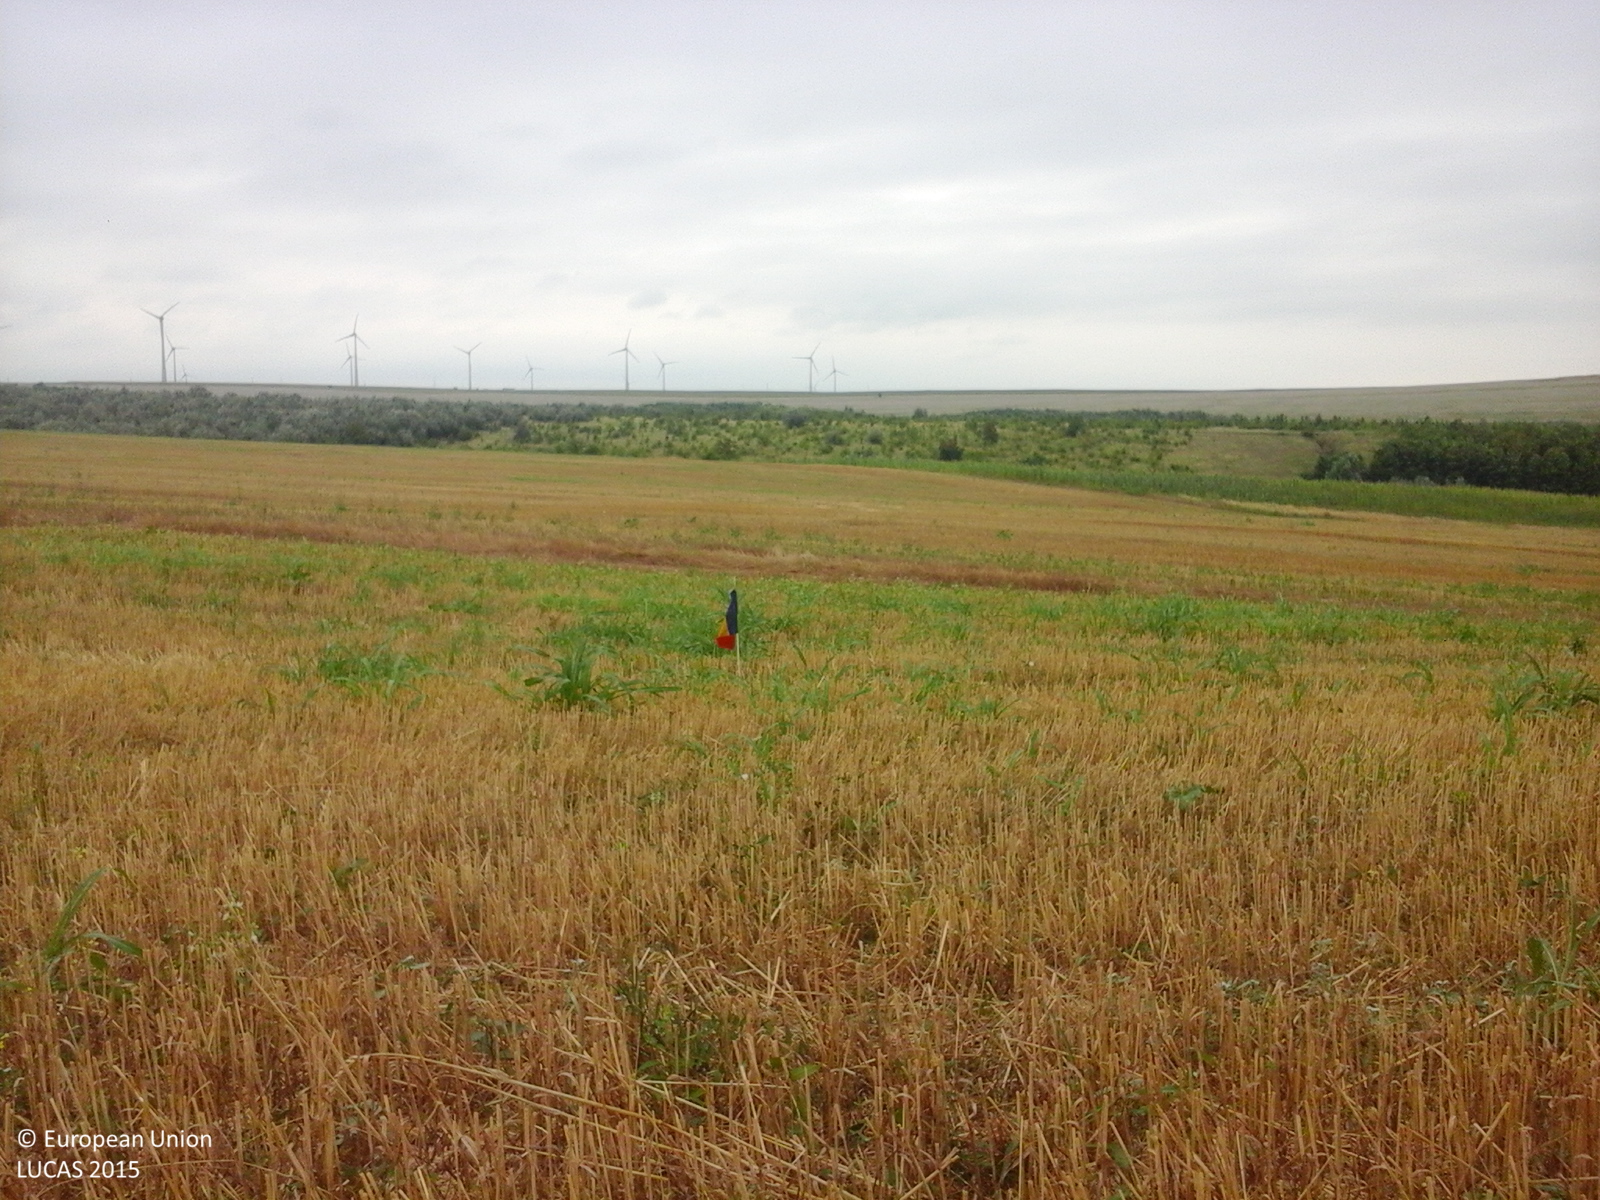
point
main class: Cropland
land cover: Durum wheat
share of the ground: 50 - 75 %
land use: Agriculture (excluding fallow land and kitchen gardens)
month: August
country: RO
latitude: 44.8424
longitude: 28.2221
